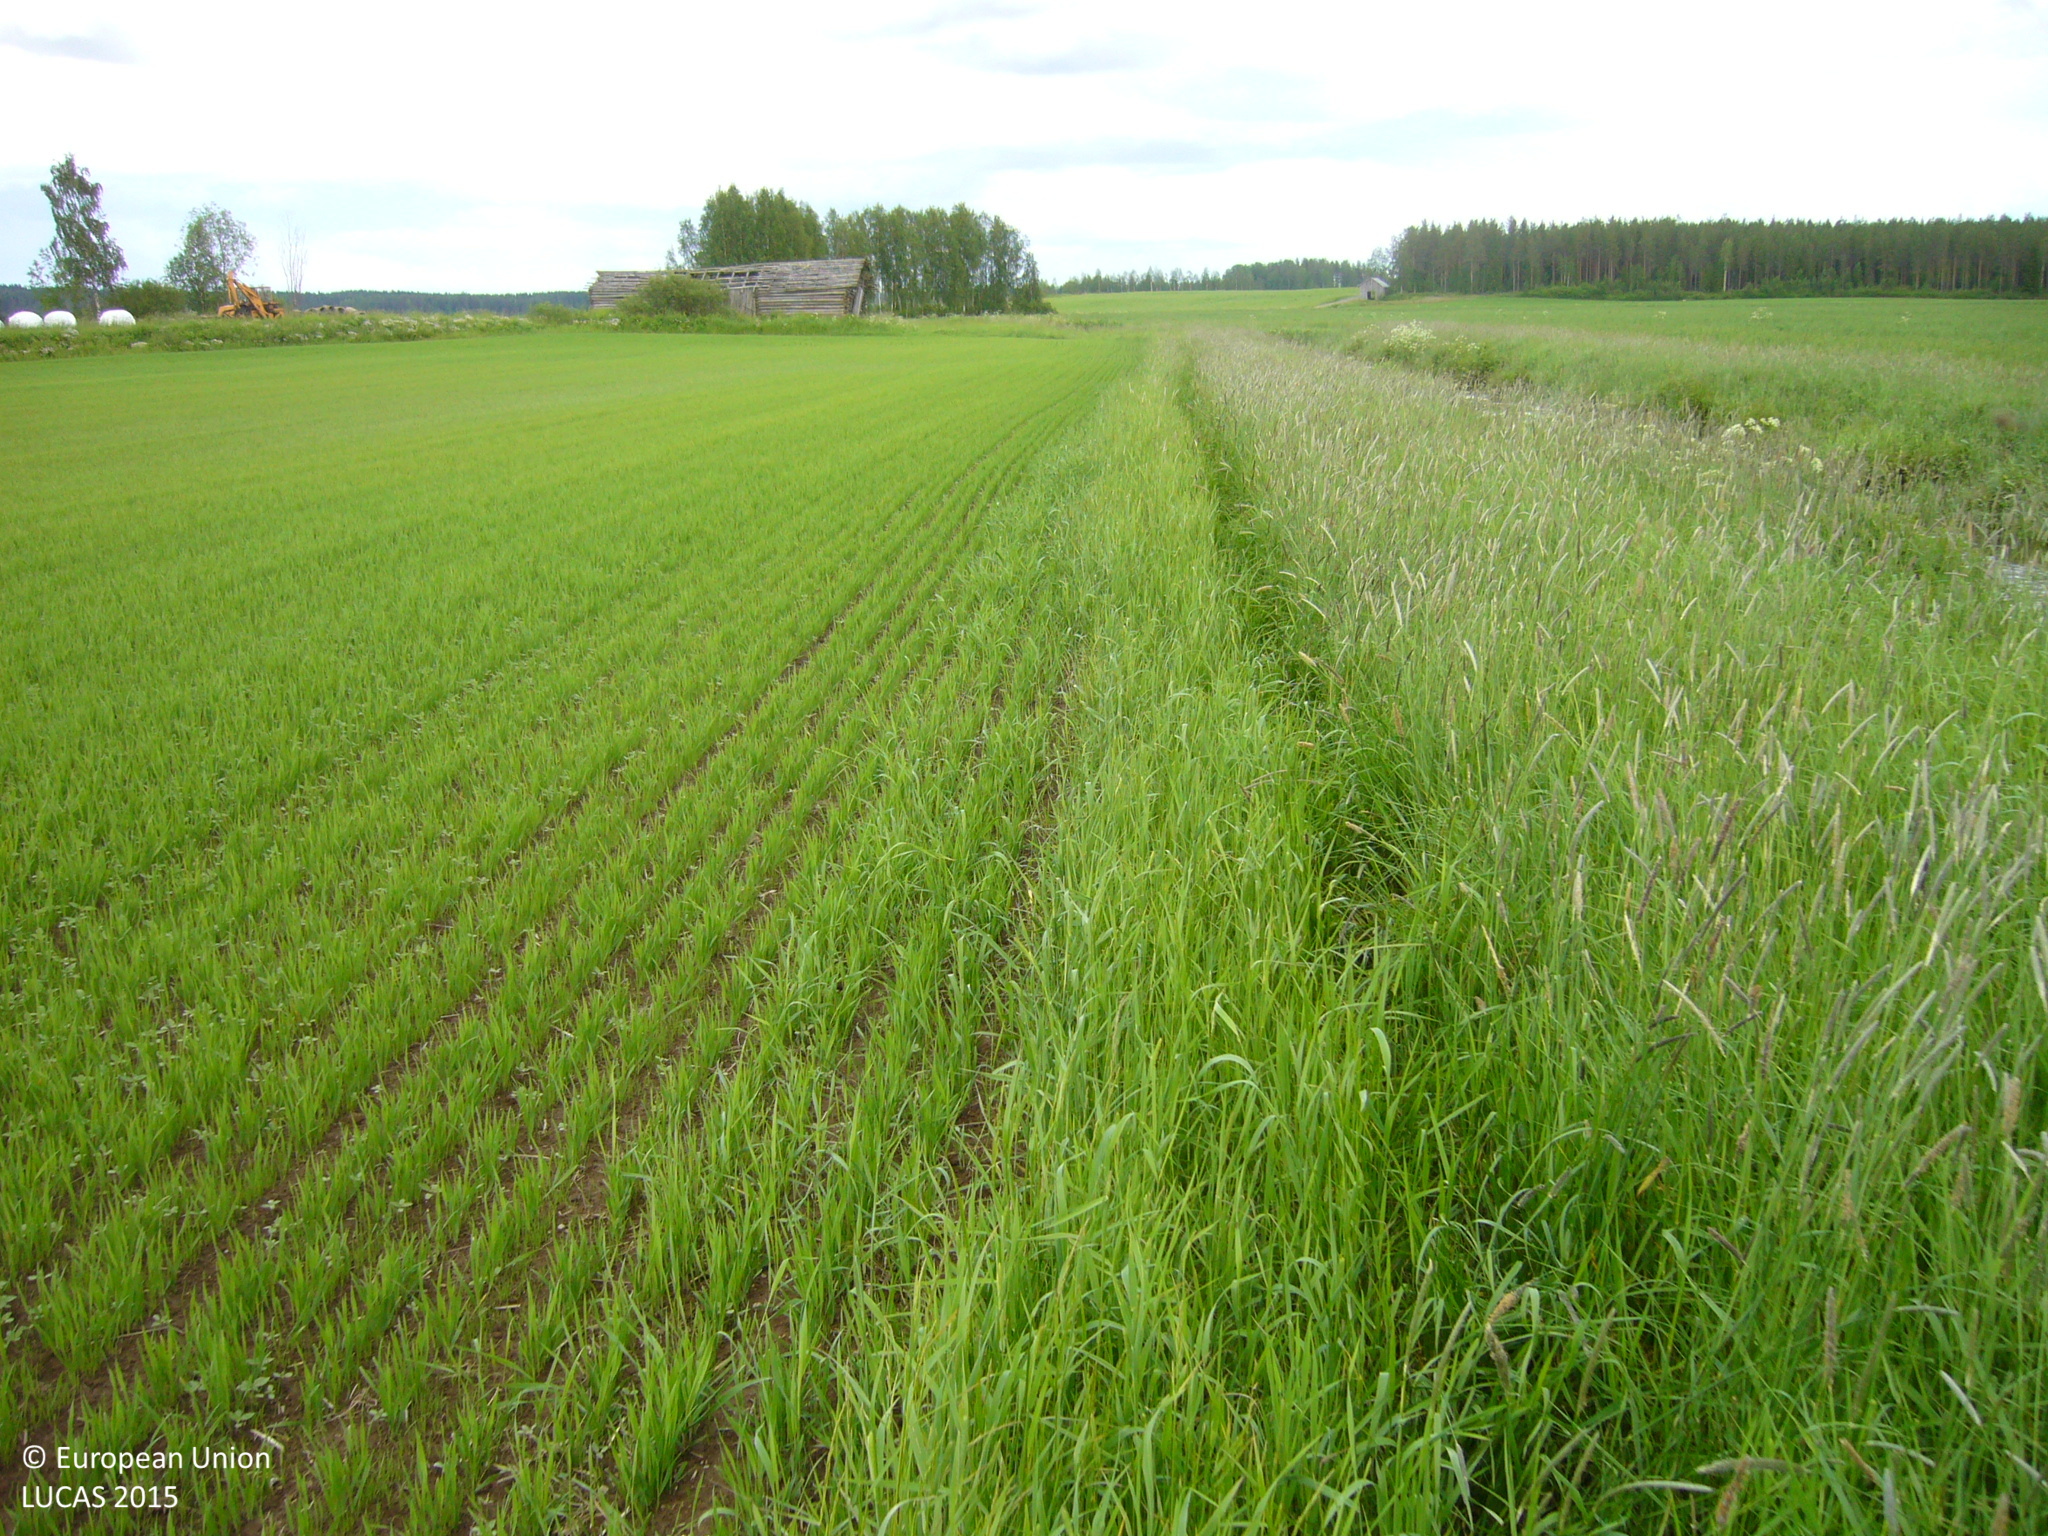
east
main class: Cropland
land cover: Barley
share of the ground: 50 - 75 %
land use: Agriculture (excluding fallow land and kitchen gardens)
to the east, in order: Barley; Shruby margins; Artificial constructions in urban areas; Grass margins; Barley; Grass margins; Inland fresh running water; Shruby margins; Broadleaved woodland
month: June
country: FI
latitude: 63.7409
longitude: 26.3885
